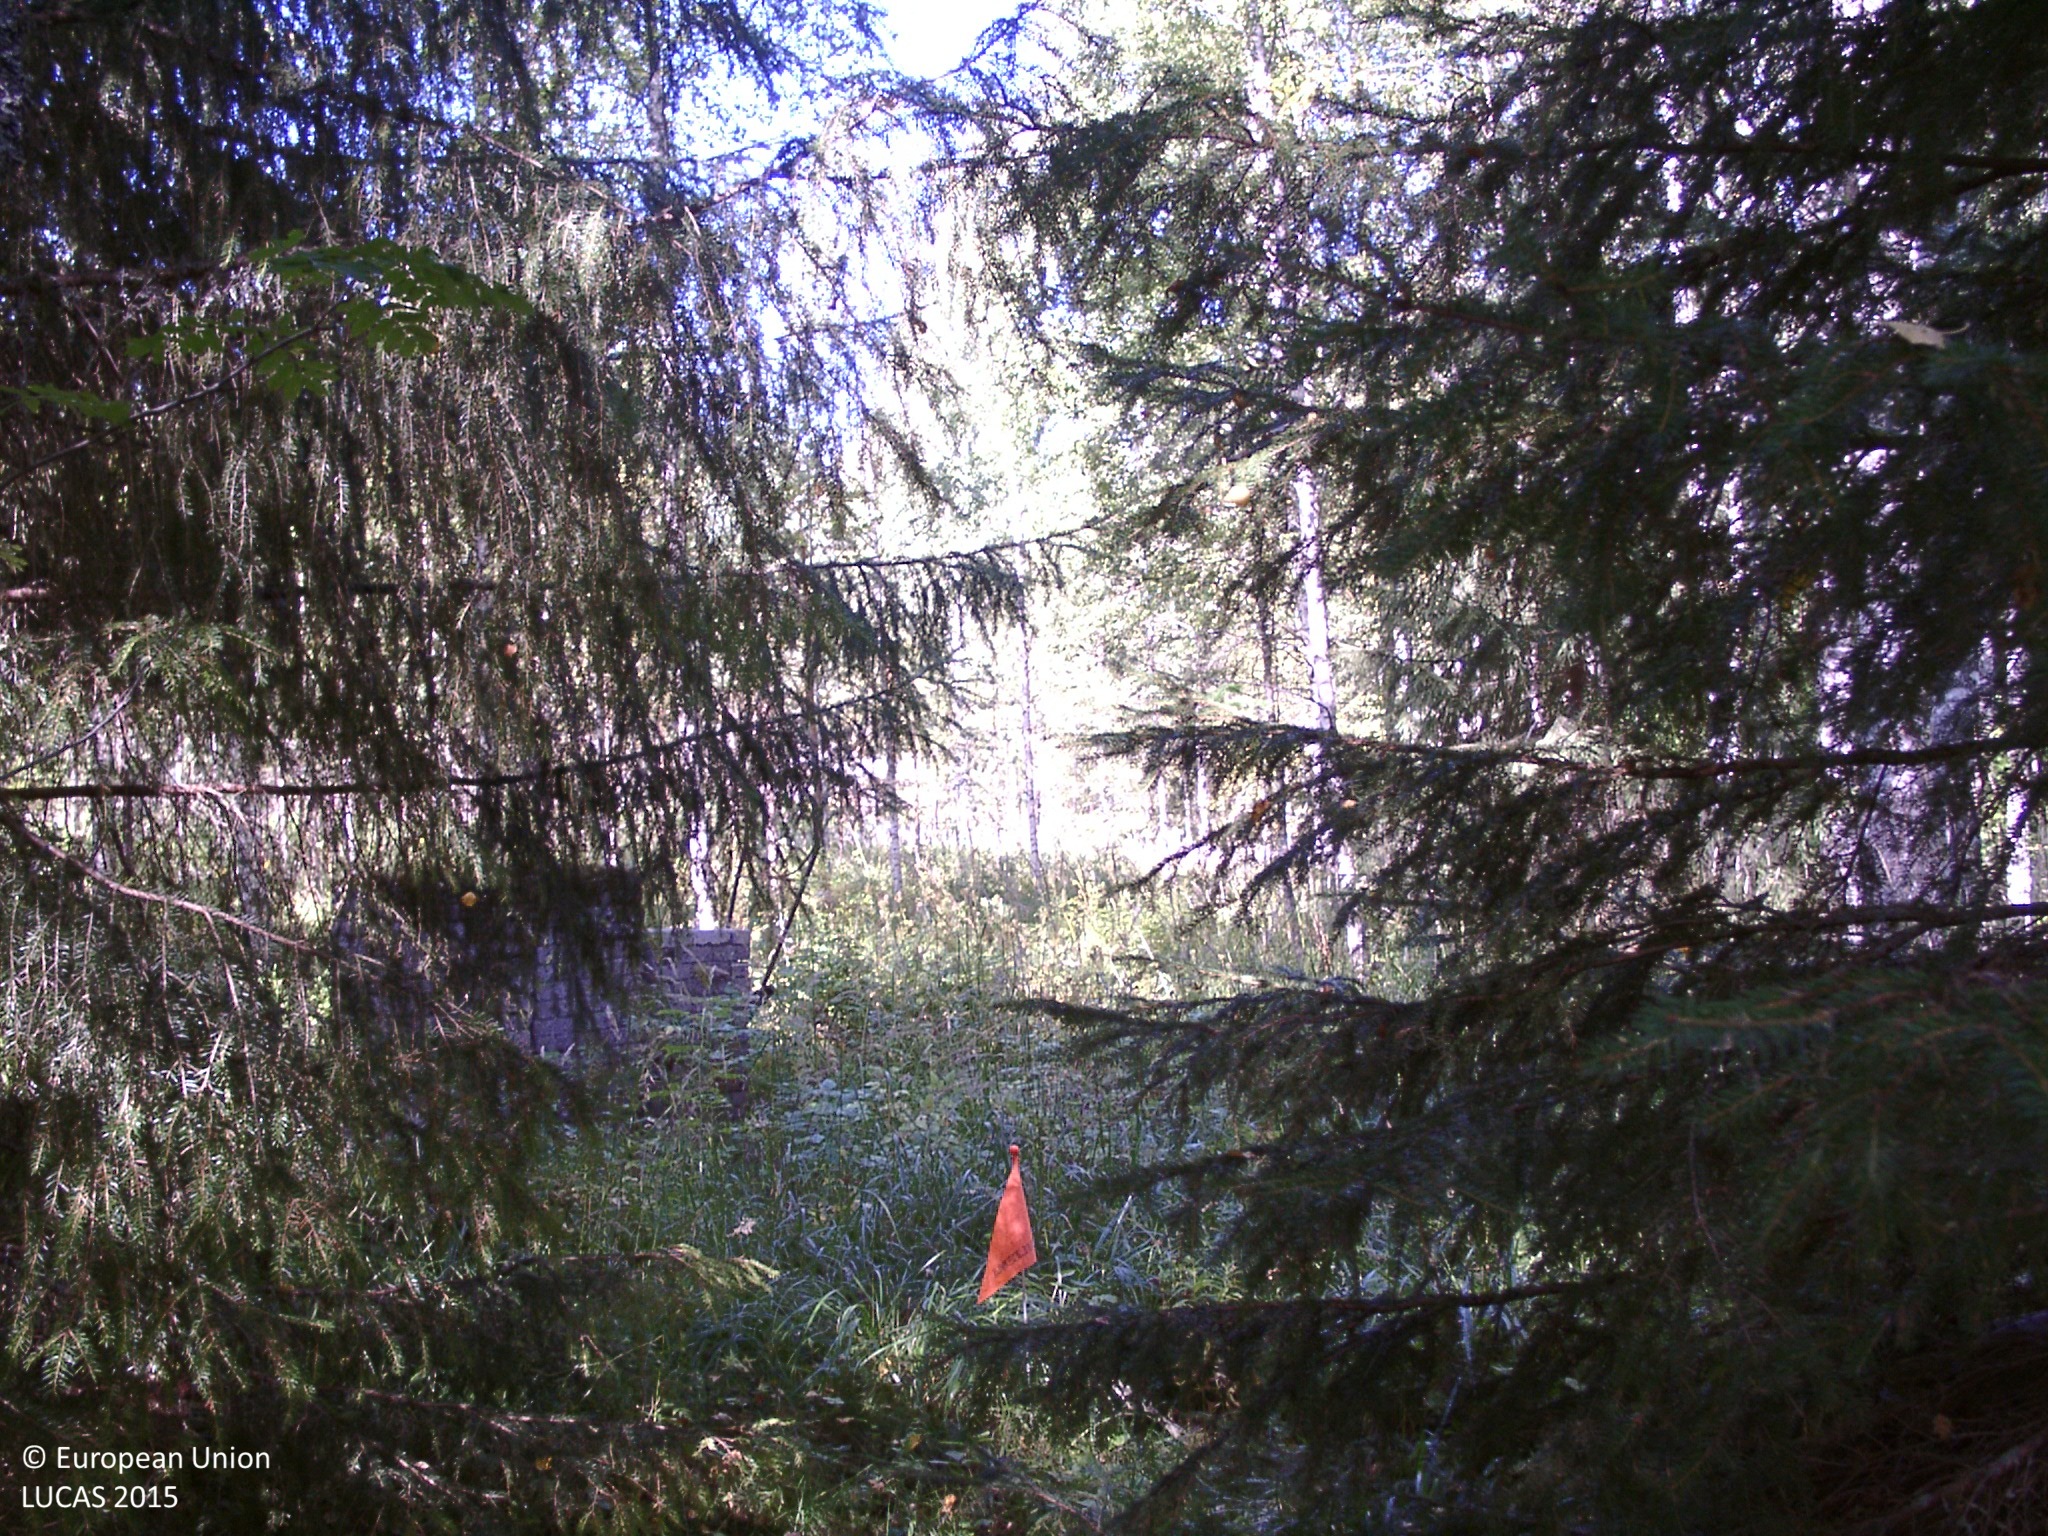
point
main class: Woodland
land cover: Broadleaved woodland
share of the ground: 50 - 75 %
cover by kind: broadleaved forest trees 55 %, herbaceous plants 30 %, coniferous forest trees 15 %
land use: Forestry
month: August
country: FI
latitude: 61.9613
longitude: 25.0376
